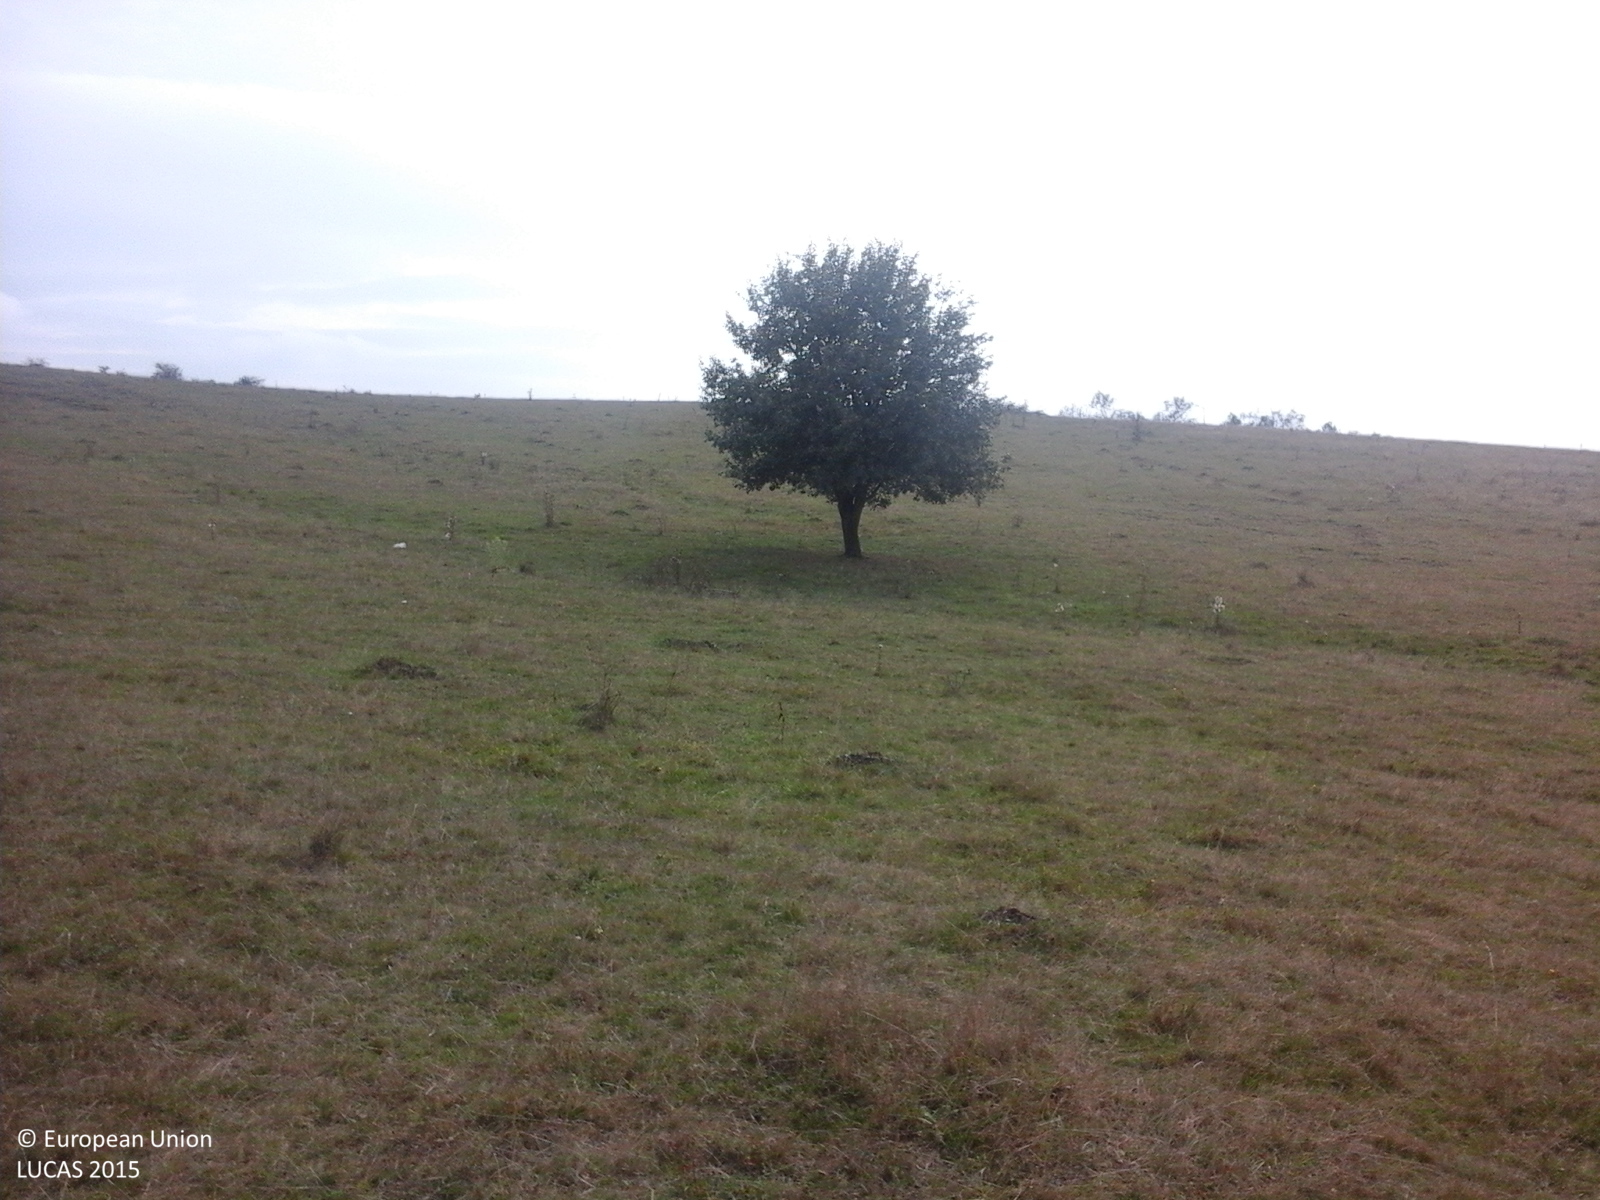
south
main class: Grassland
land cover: Grassland without tree/shrub cover
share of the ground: > 75 %
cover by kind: herbaceous plants 100 %
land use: Agriculture (excluding fallow land and kitchen gardens)
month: October
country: RO
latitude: 46.0753
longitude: 25.2406
